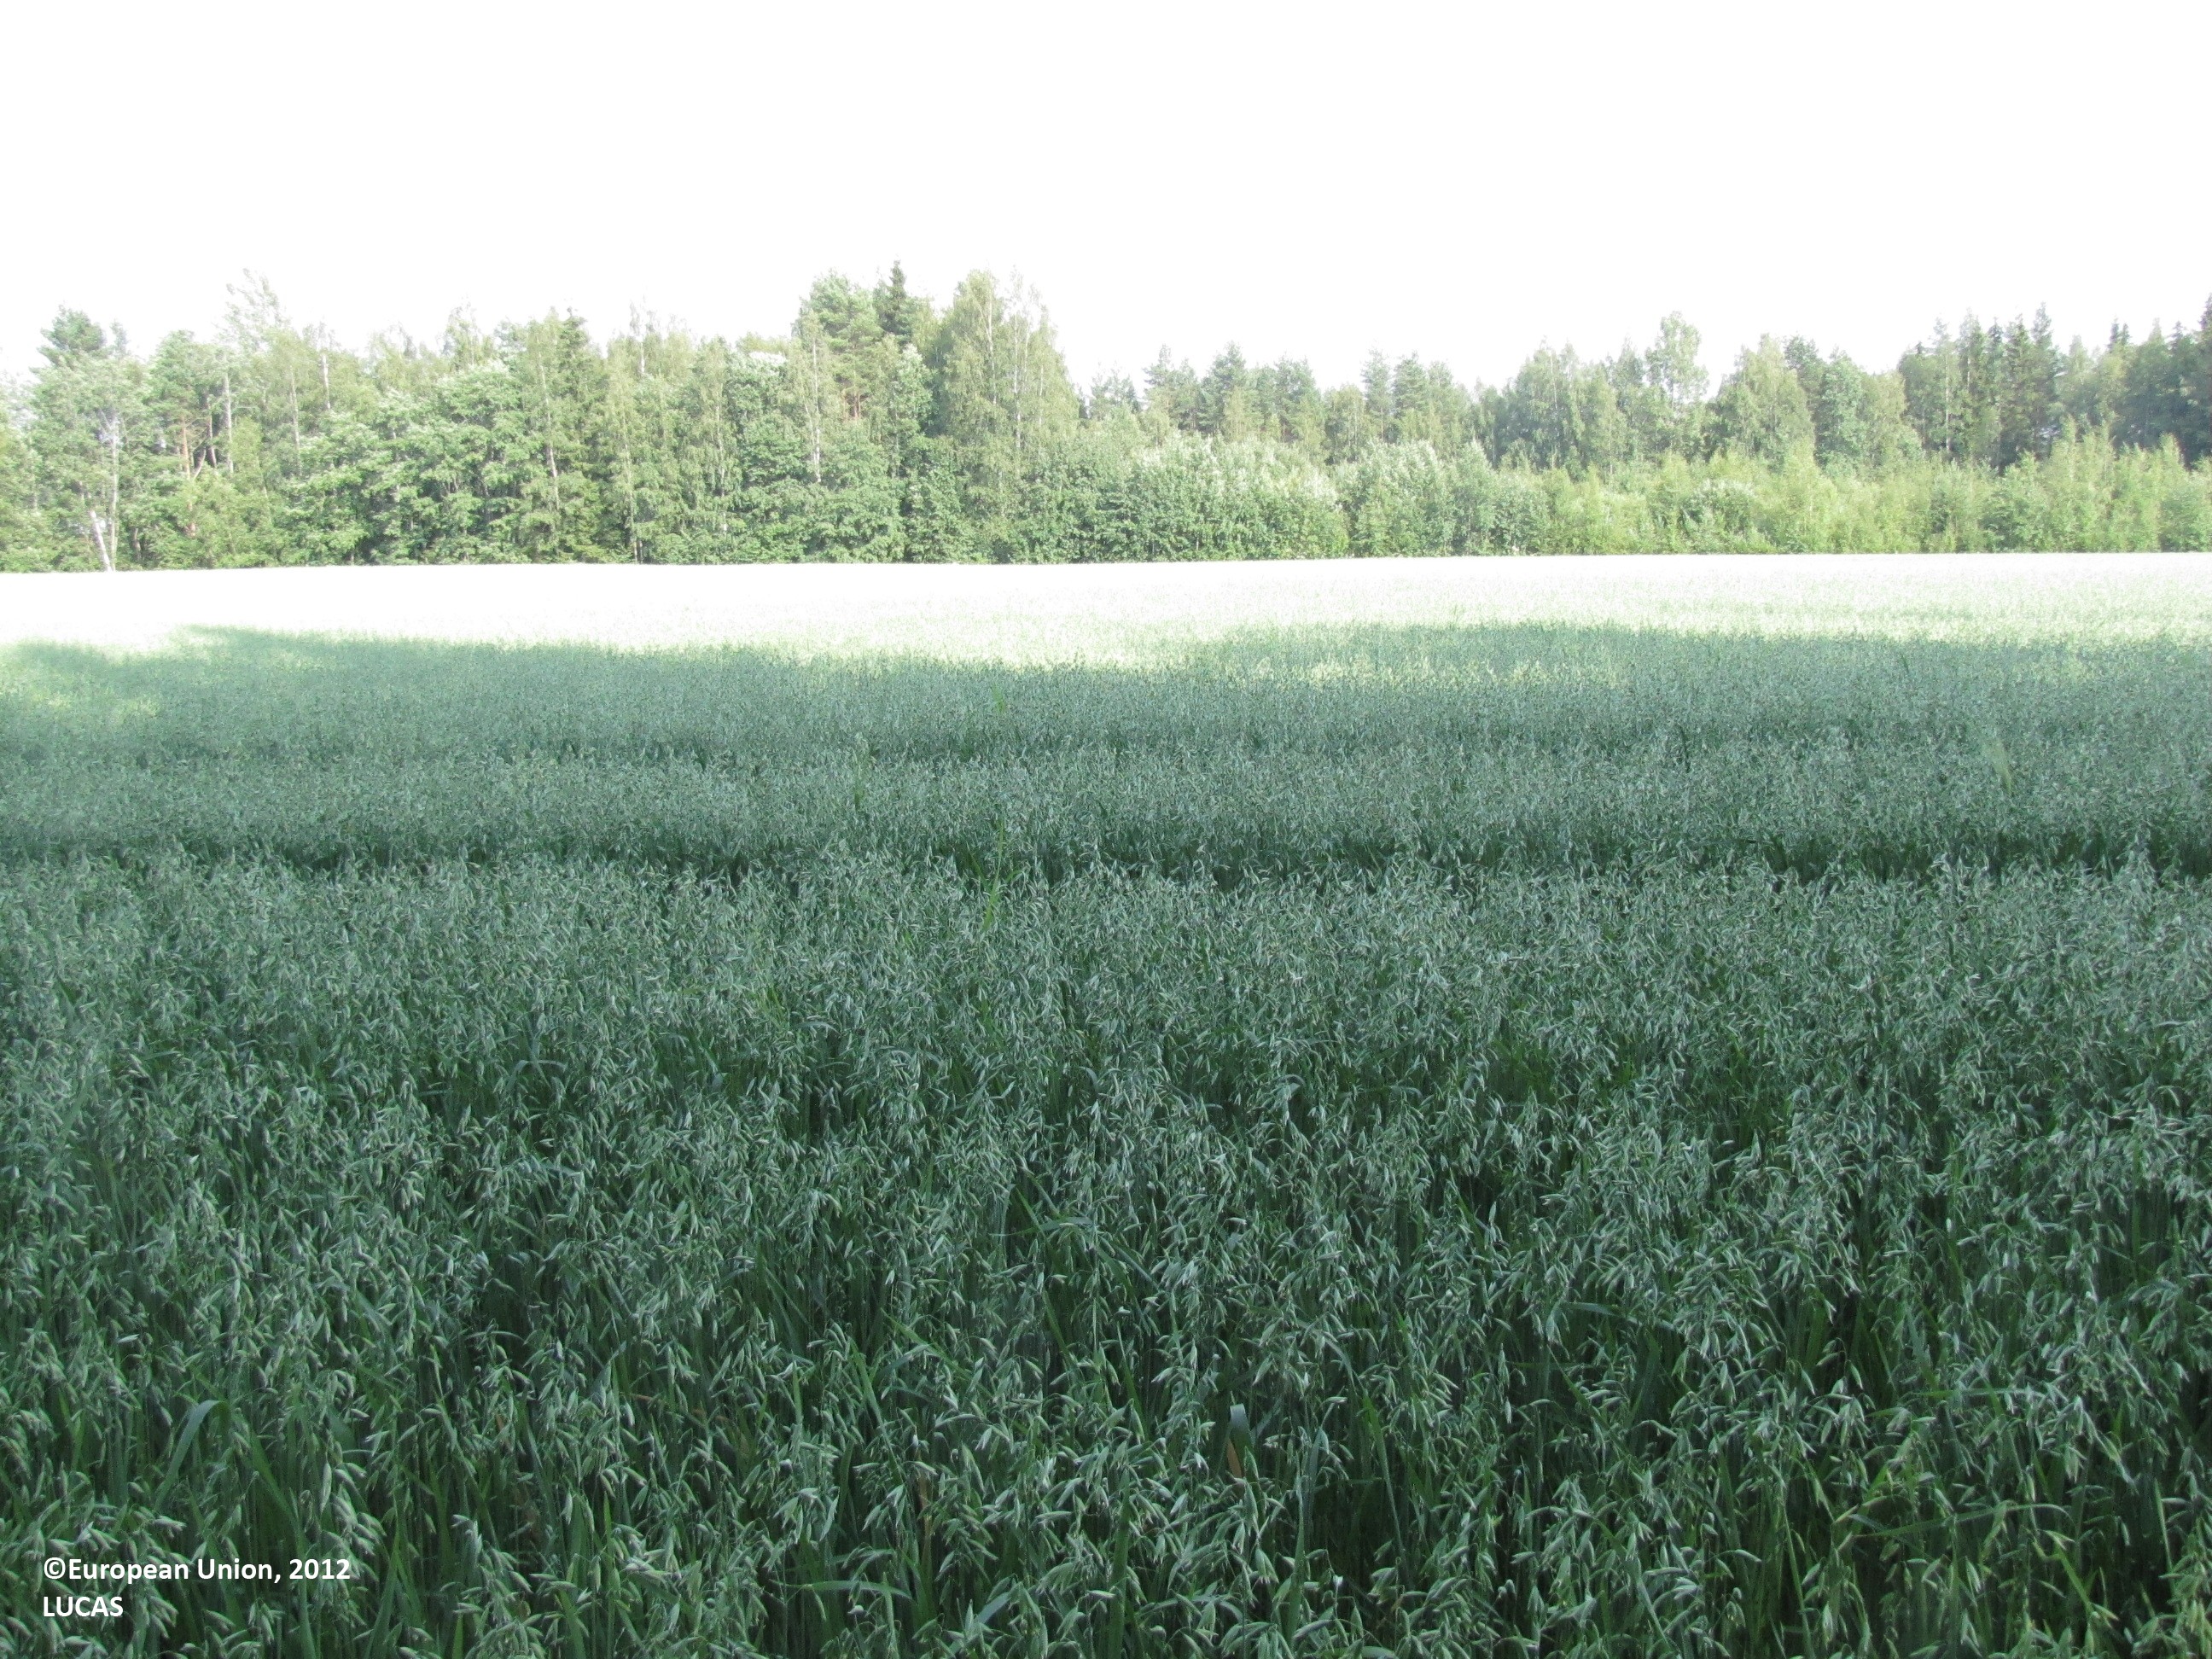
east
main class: Cropland
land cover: Oats
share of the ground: > 75 %
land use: Agriculture (excluding fallow land and kitchen gardens)
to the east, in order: Oats; Grass margins; Ditches and canals; Broadleaved woodland; Ditches and canals; Broadleaved woodland; Ditches and canals; Broadleaved woodland; Ditches and canals; Broadleaved woodland; Ditches and canals; Broadleaved woodland; Ditches and canals; Broadleaved woodland; Other mixed woodland; Rivers and streams; Broadleaved woodland; Grassland without tree/shrub cover; Abandoned hedges; Ditches and canals; Grassland without tree/shrub cover; Abandoned hedges; Ditches and canals; Broadleaved woodland
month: July
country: FI
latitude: 61.9564
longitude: 22.9751
